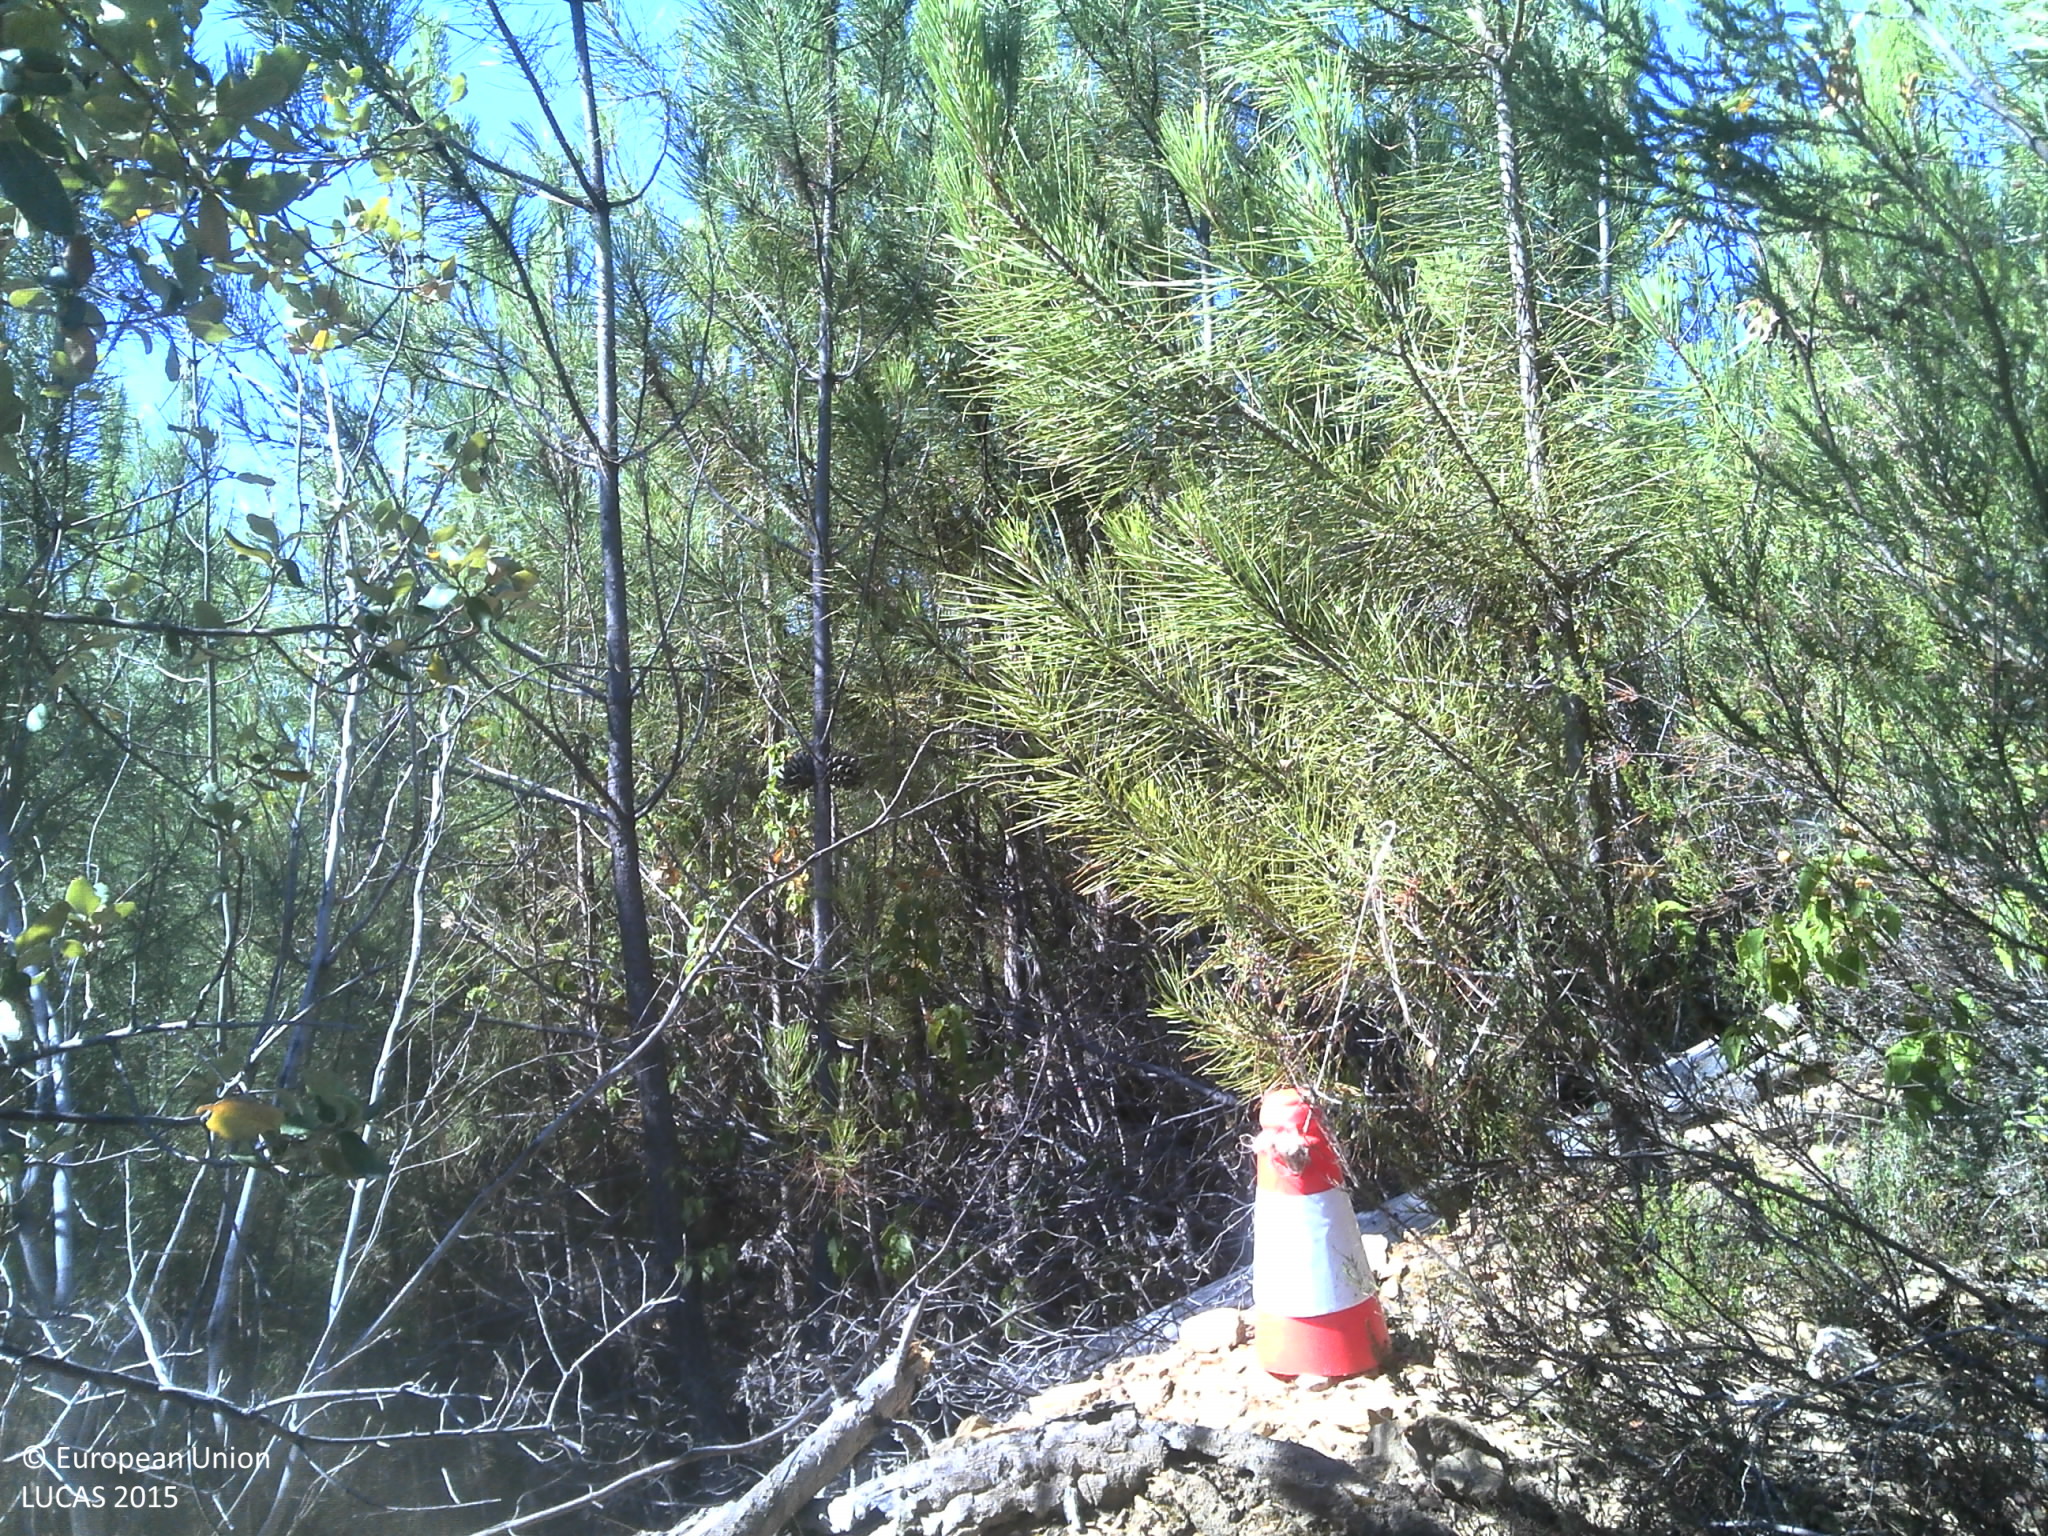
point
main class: Woodland
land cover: Pine dominated coniferous woodland
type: coniferous forest of the mediterranean region
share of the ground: 25 - 50 %
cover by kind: coniferous forest trees 50 %, shrubs 40 %, unconsolidated bare surface 10 %
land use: Forestry
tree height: < 5 m
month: July
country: PT
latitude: 40.0157
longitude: -7.6690
